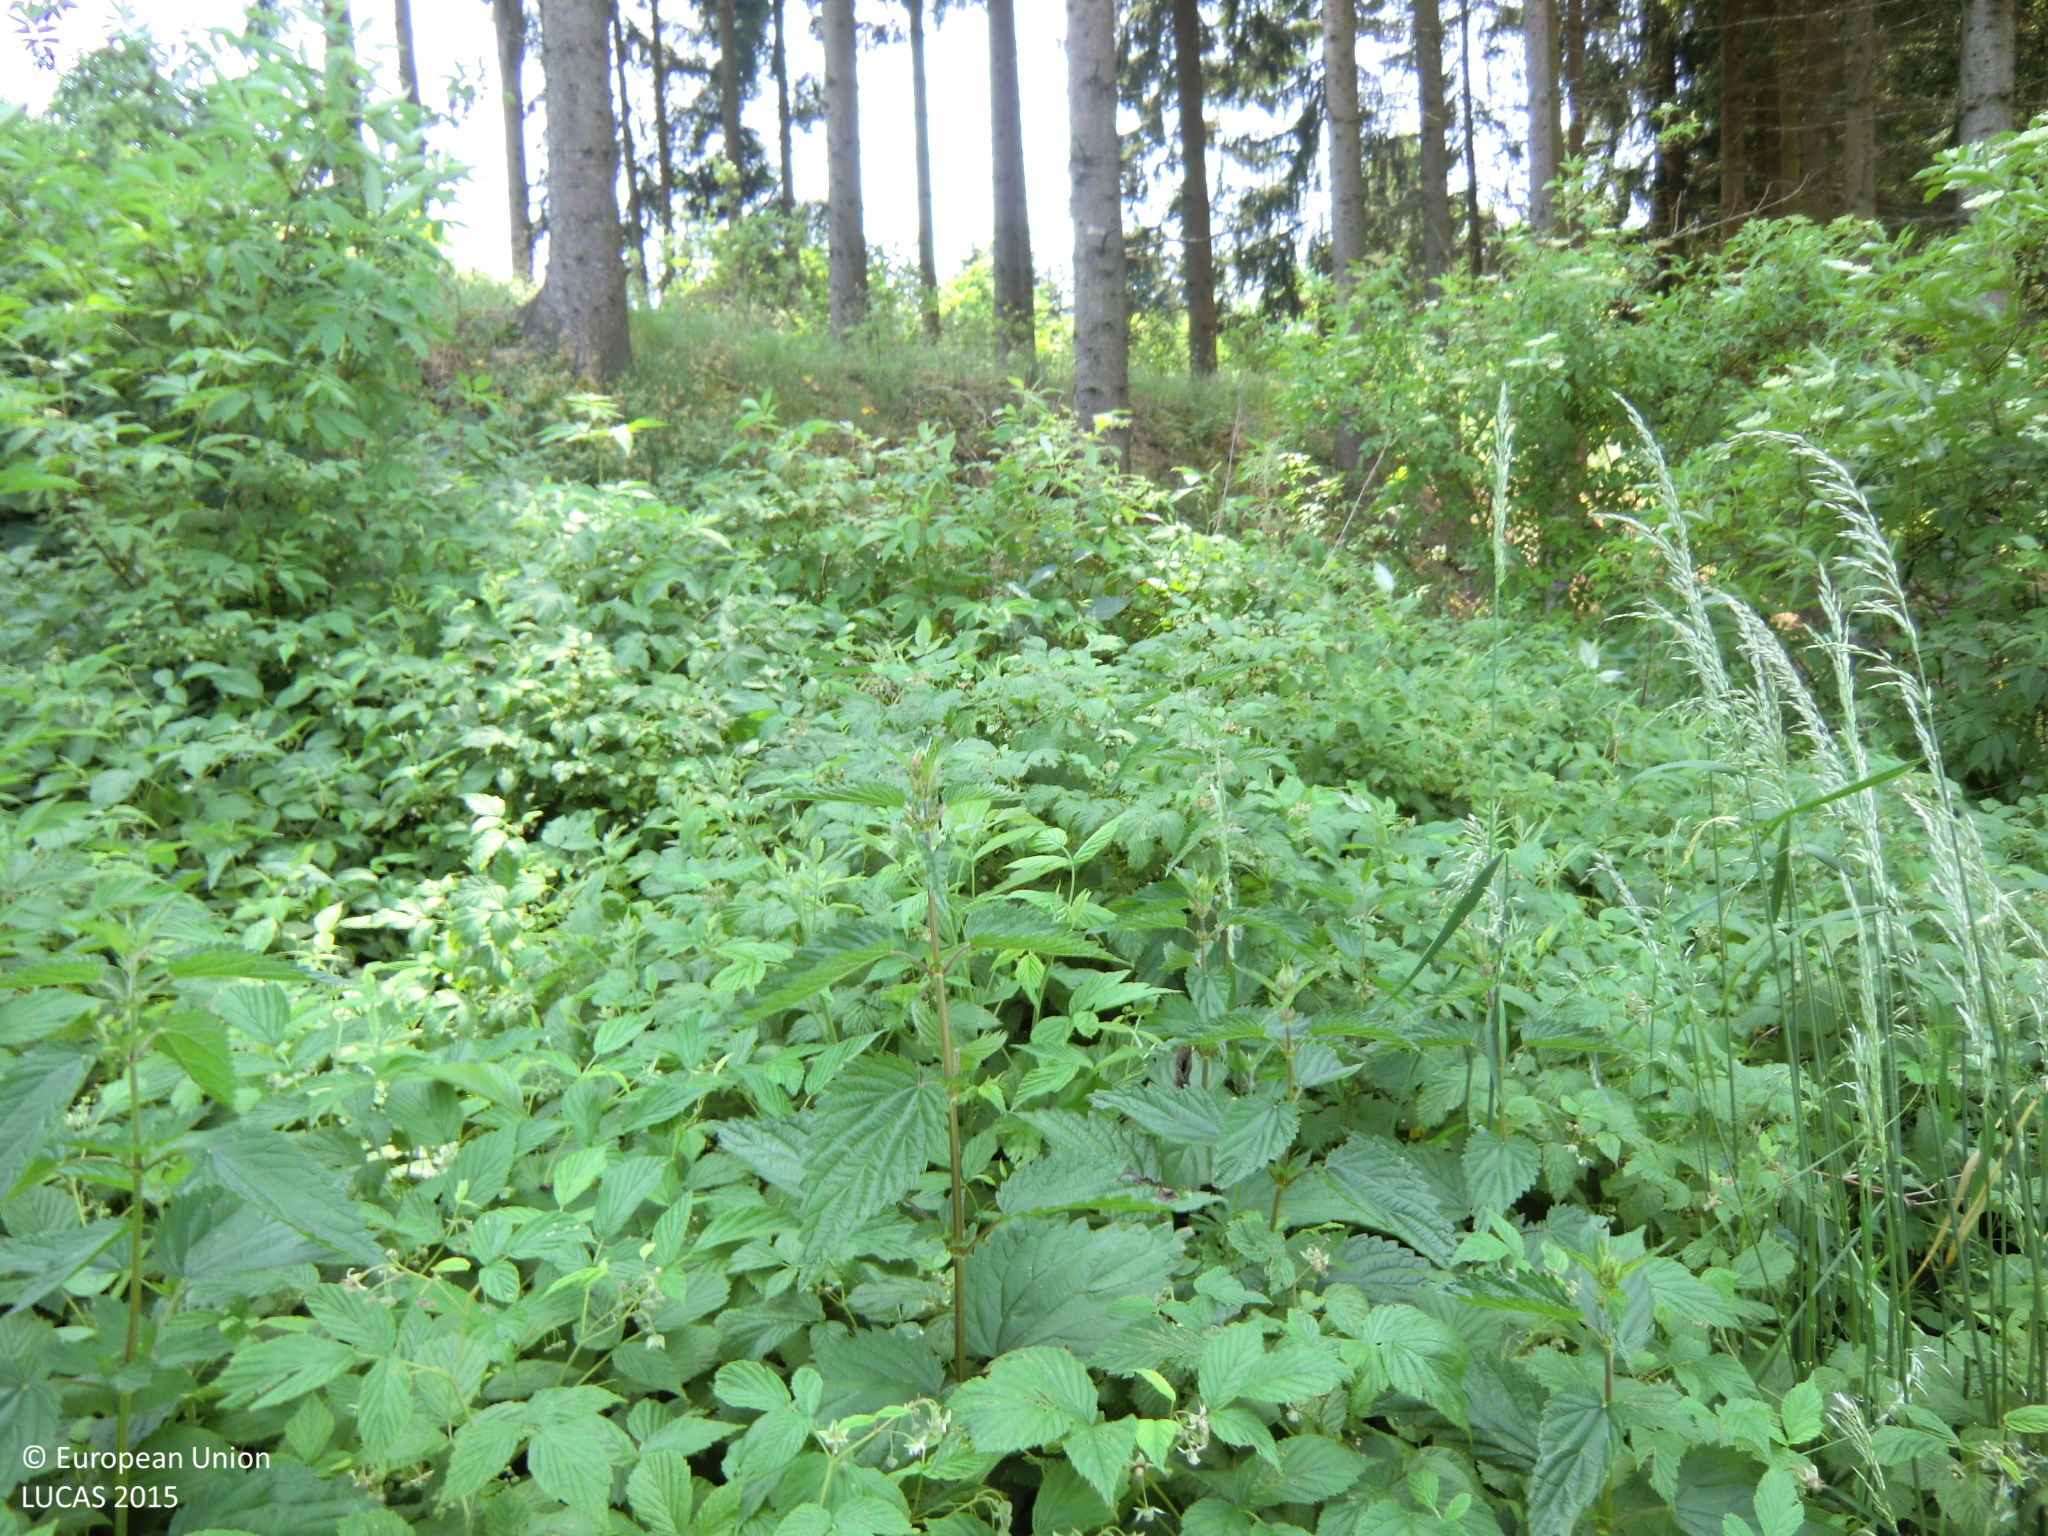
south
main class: Shrubland
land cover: Shrubland without tree cover
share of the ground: > 75 %
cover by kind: herbaceous plants 80 %, shrubs 20 %
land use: Forestry
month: June
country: AT
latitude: 48.3908
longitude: 14.7682
